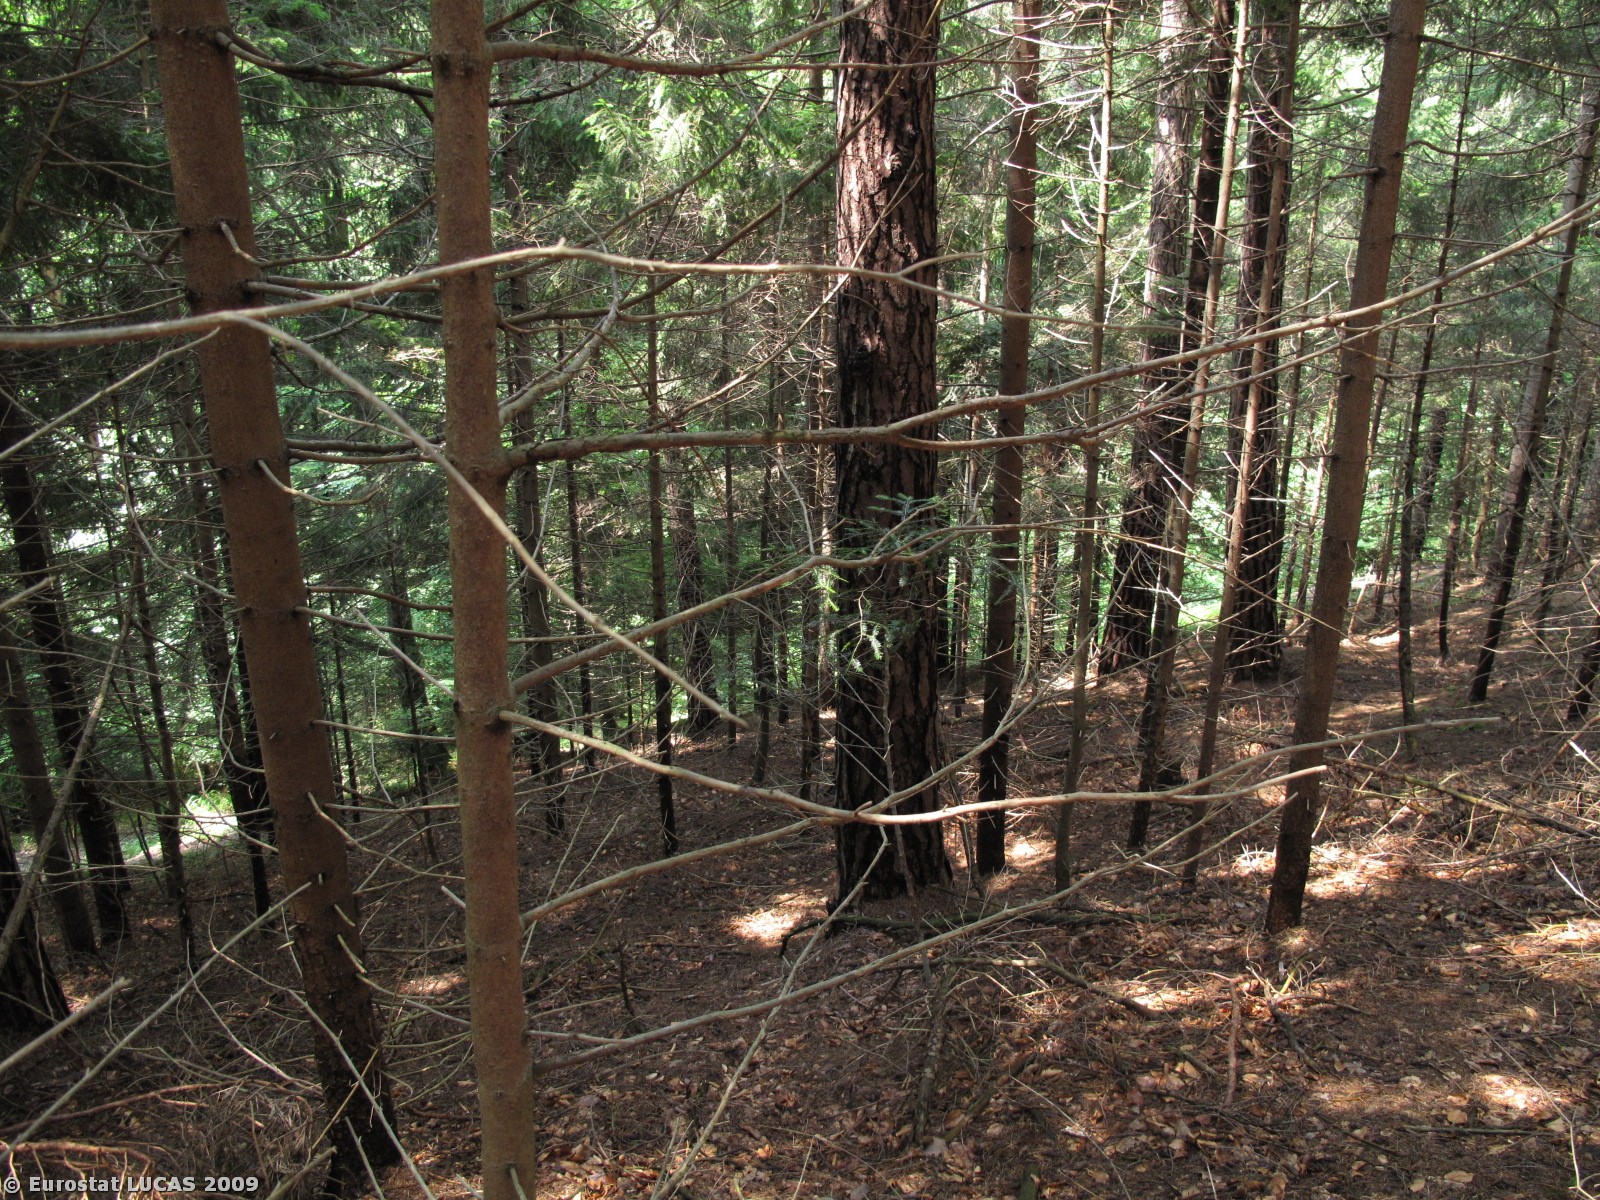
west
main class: Woodland
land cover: Coniferous woodland
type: alpine coniferous forest
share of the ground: 50 - 75 %
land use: Forestry
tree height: > 5 m
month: June
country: AT
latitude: 48.1418
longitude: 15.8223
